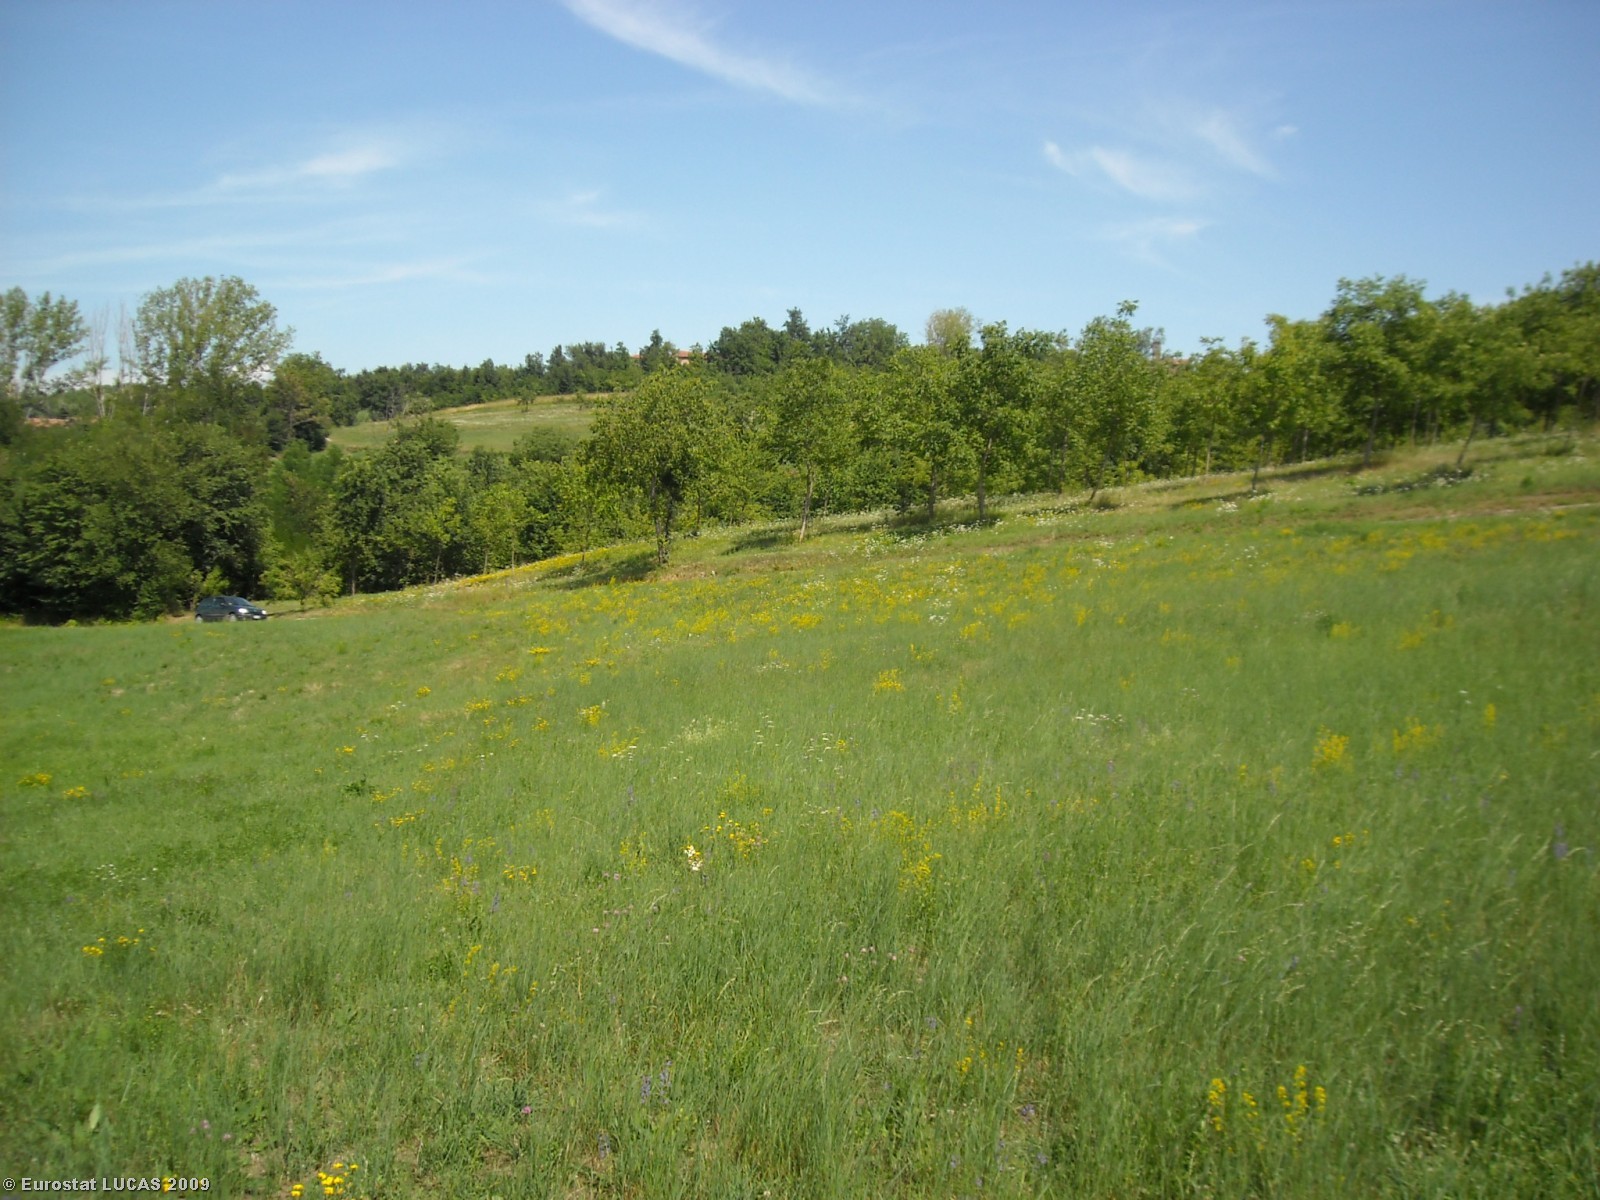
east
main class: Grassland
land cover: Grassland without tree/shrub cover
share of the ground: > 75 %
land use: Agriculture (excluding fallow land and kitchen gardens)
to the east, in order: Grassland without tree/shrub cover; Paved roads, cycling and walking lanes; Grassland with sparse tree/shrub cover; Nuts trees; Grassland with sparse tree/shrub cover; Ditches and canals; Grassland with sparse tree/shrub cover; Broadleaved woodland; Groves; Rivers and streams; Broadleaved woodland; Grassland without tree/shrub cover
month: June
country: IT
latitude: 45.1625
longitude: 8.0824
